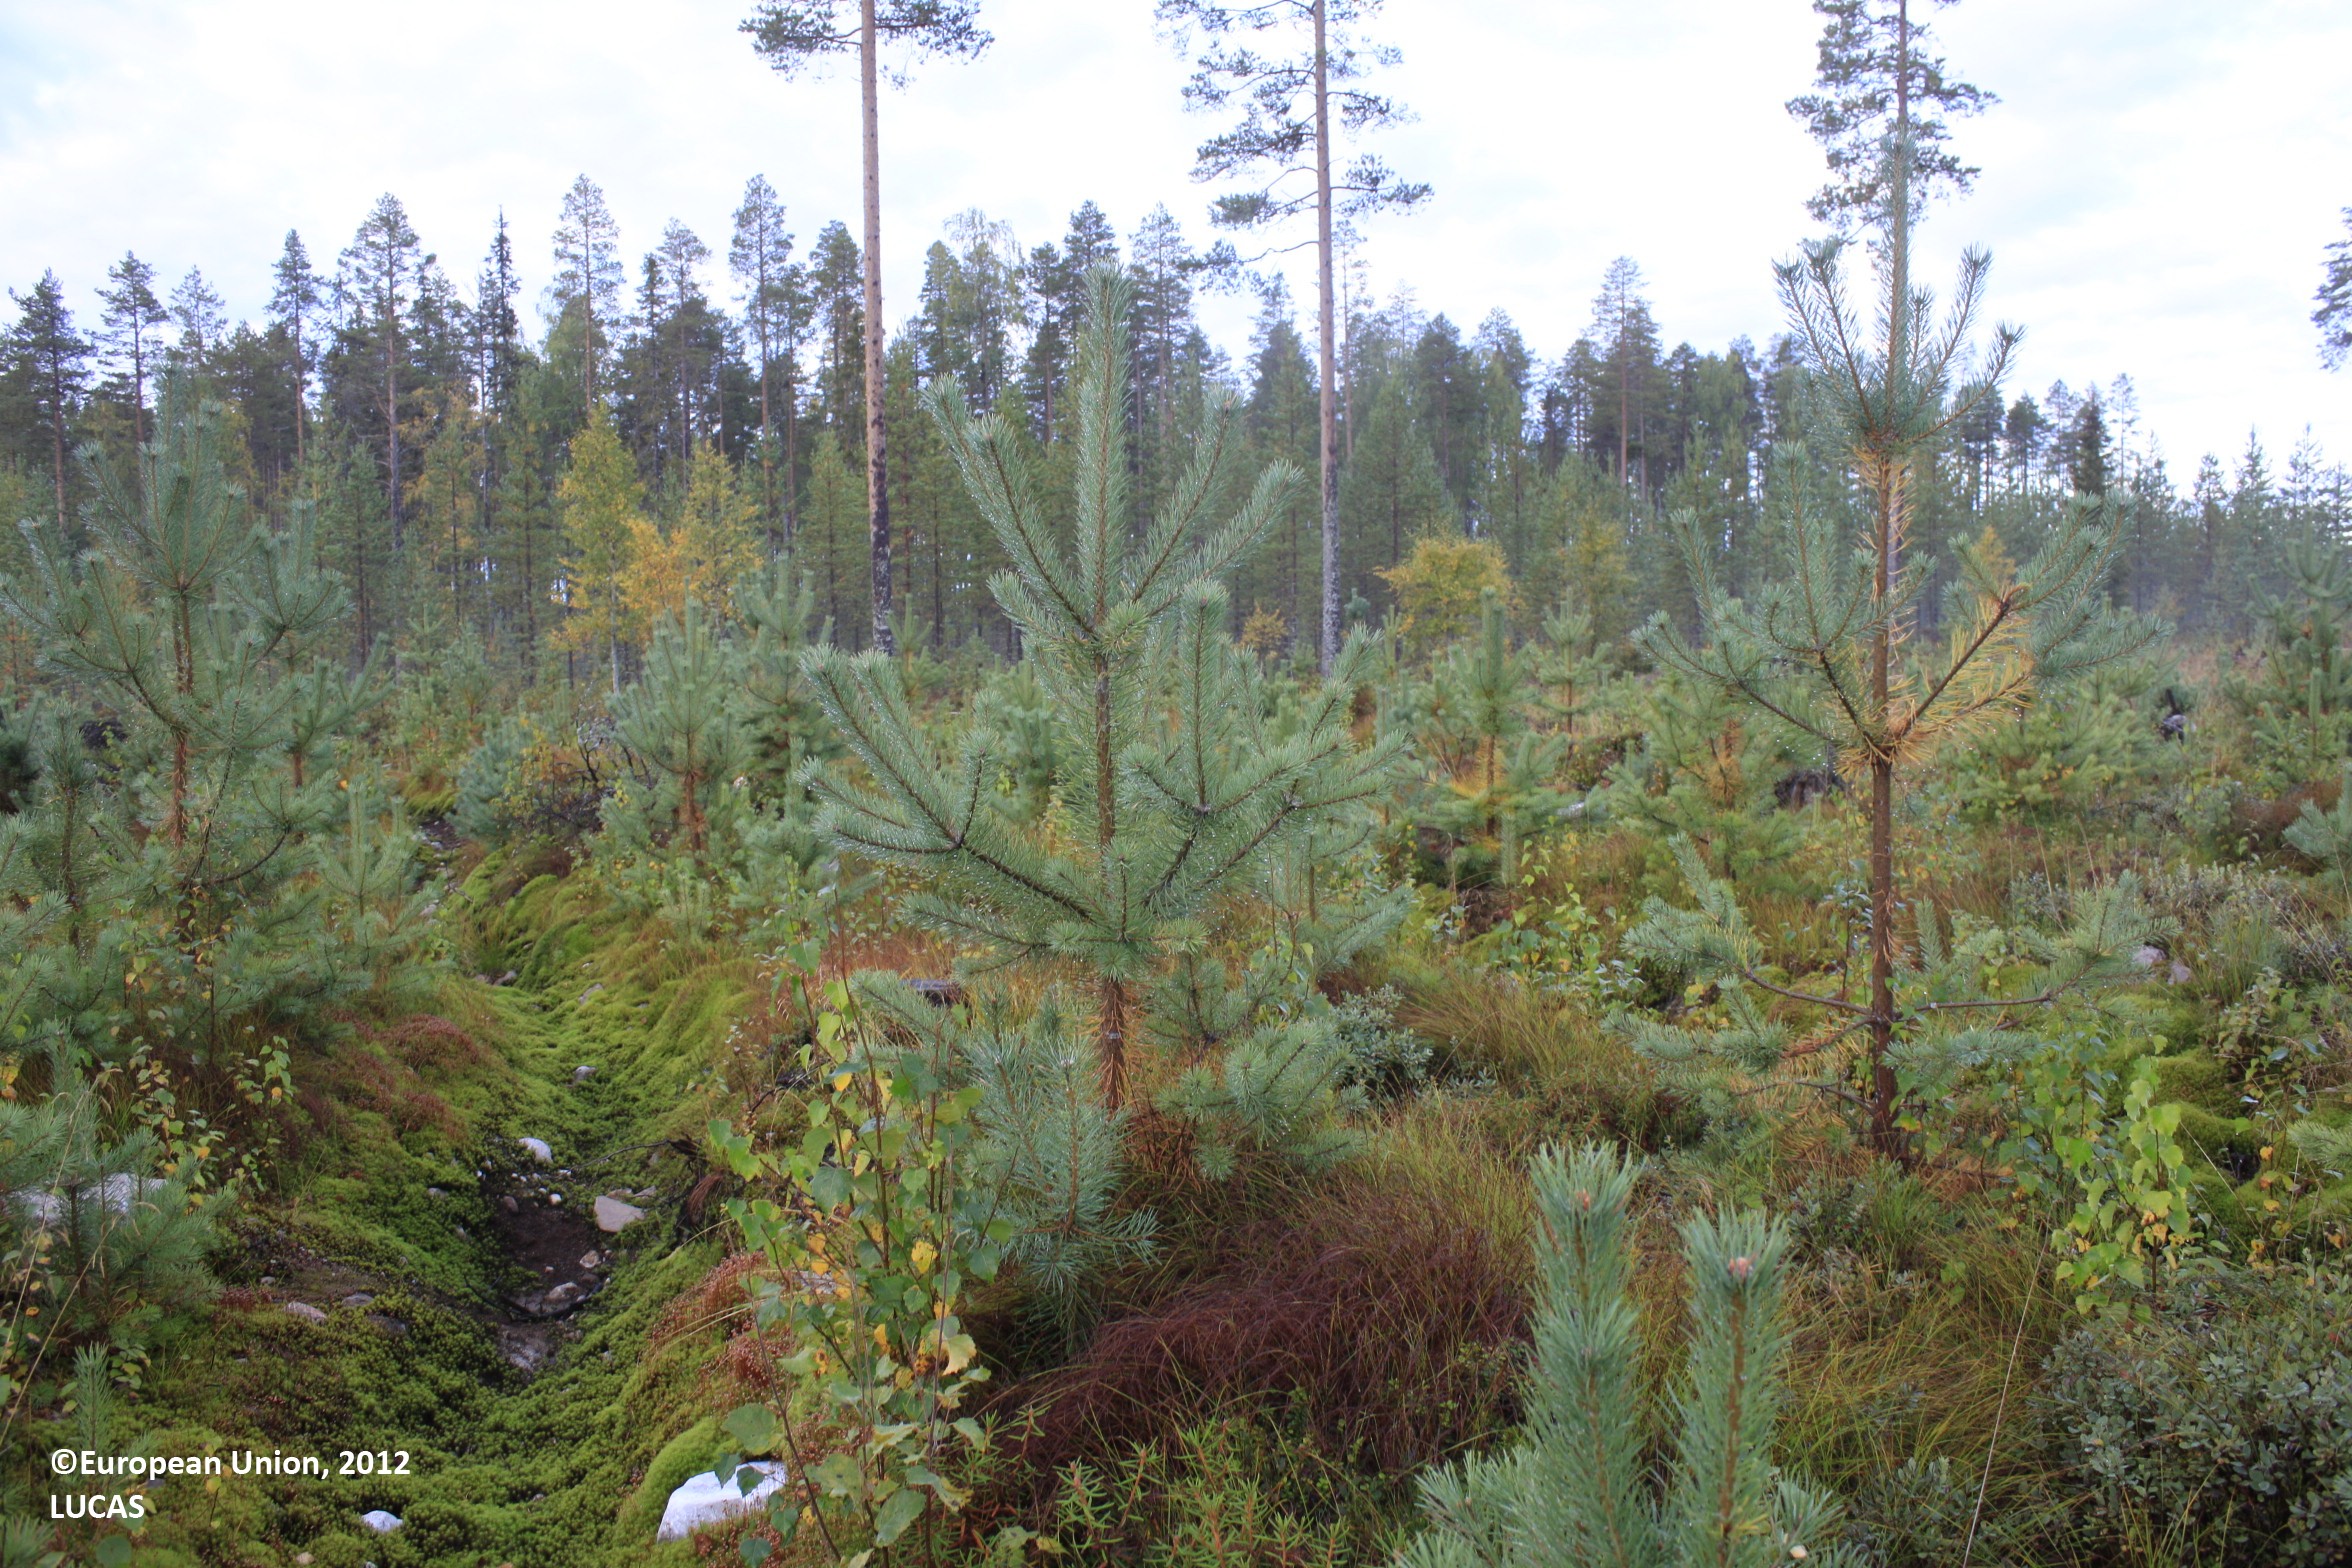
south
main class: Woodland
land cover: Pine dominated coniferous woodland
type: boreal forest
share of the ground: 25 - 50 %
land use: Forestry
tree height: < 5 m
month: September
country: FI
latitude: 65.6193
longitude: 26.7137
